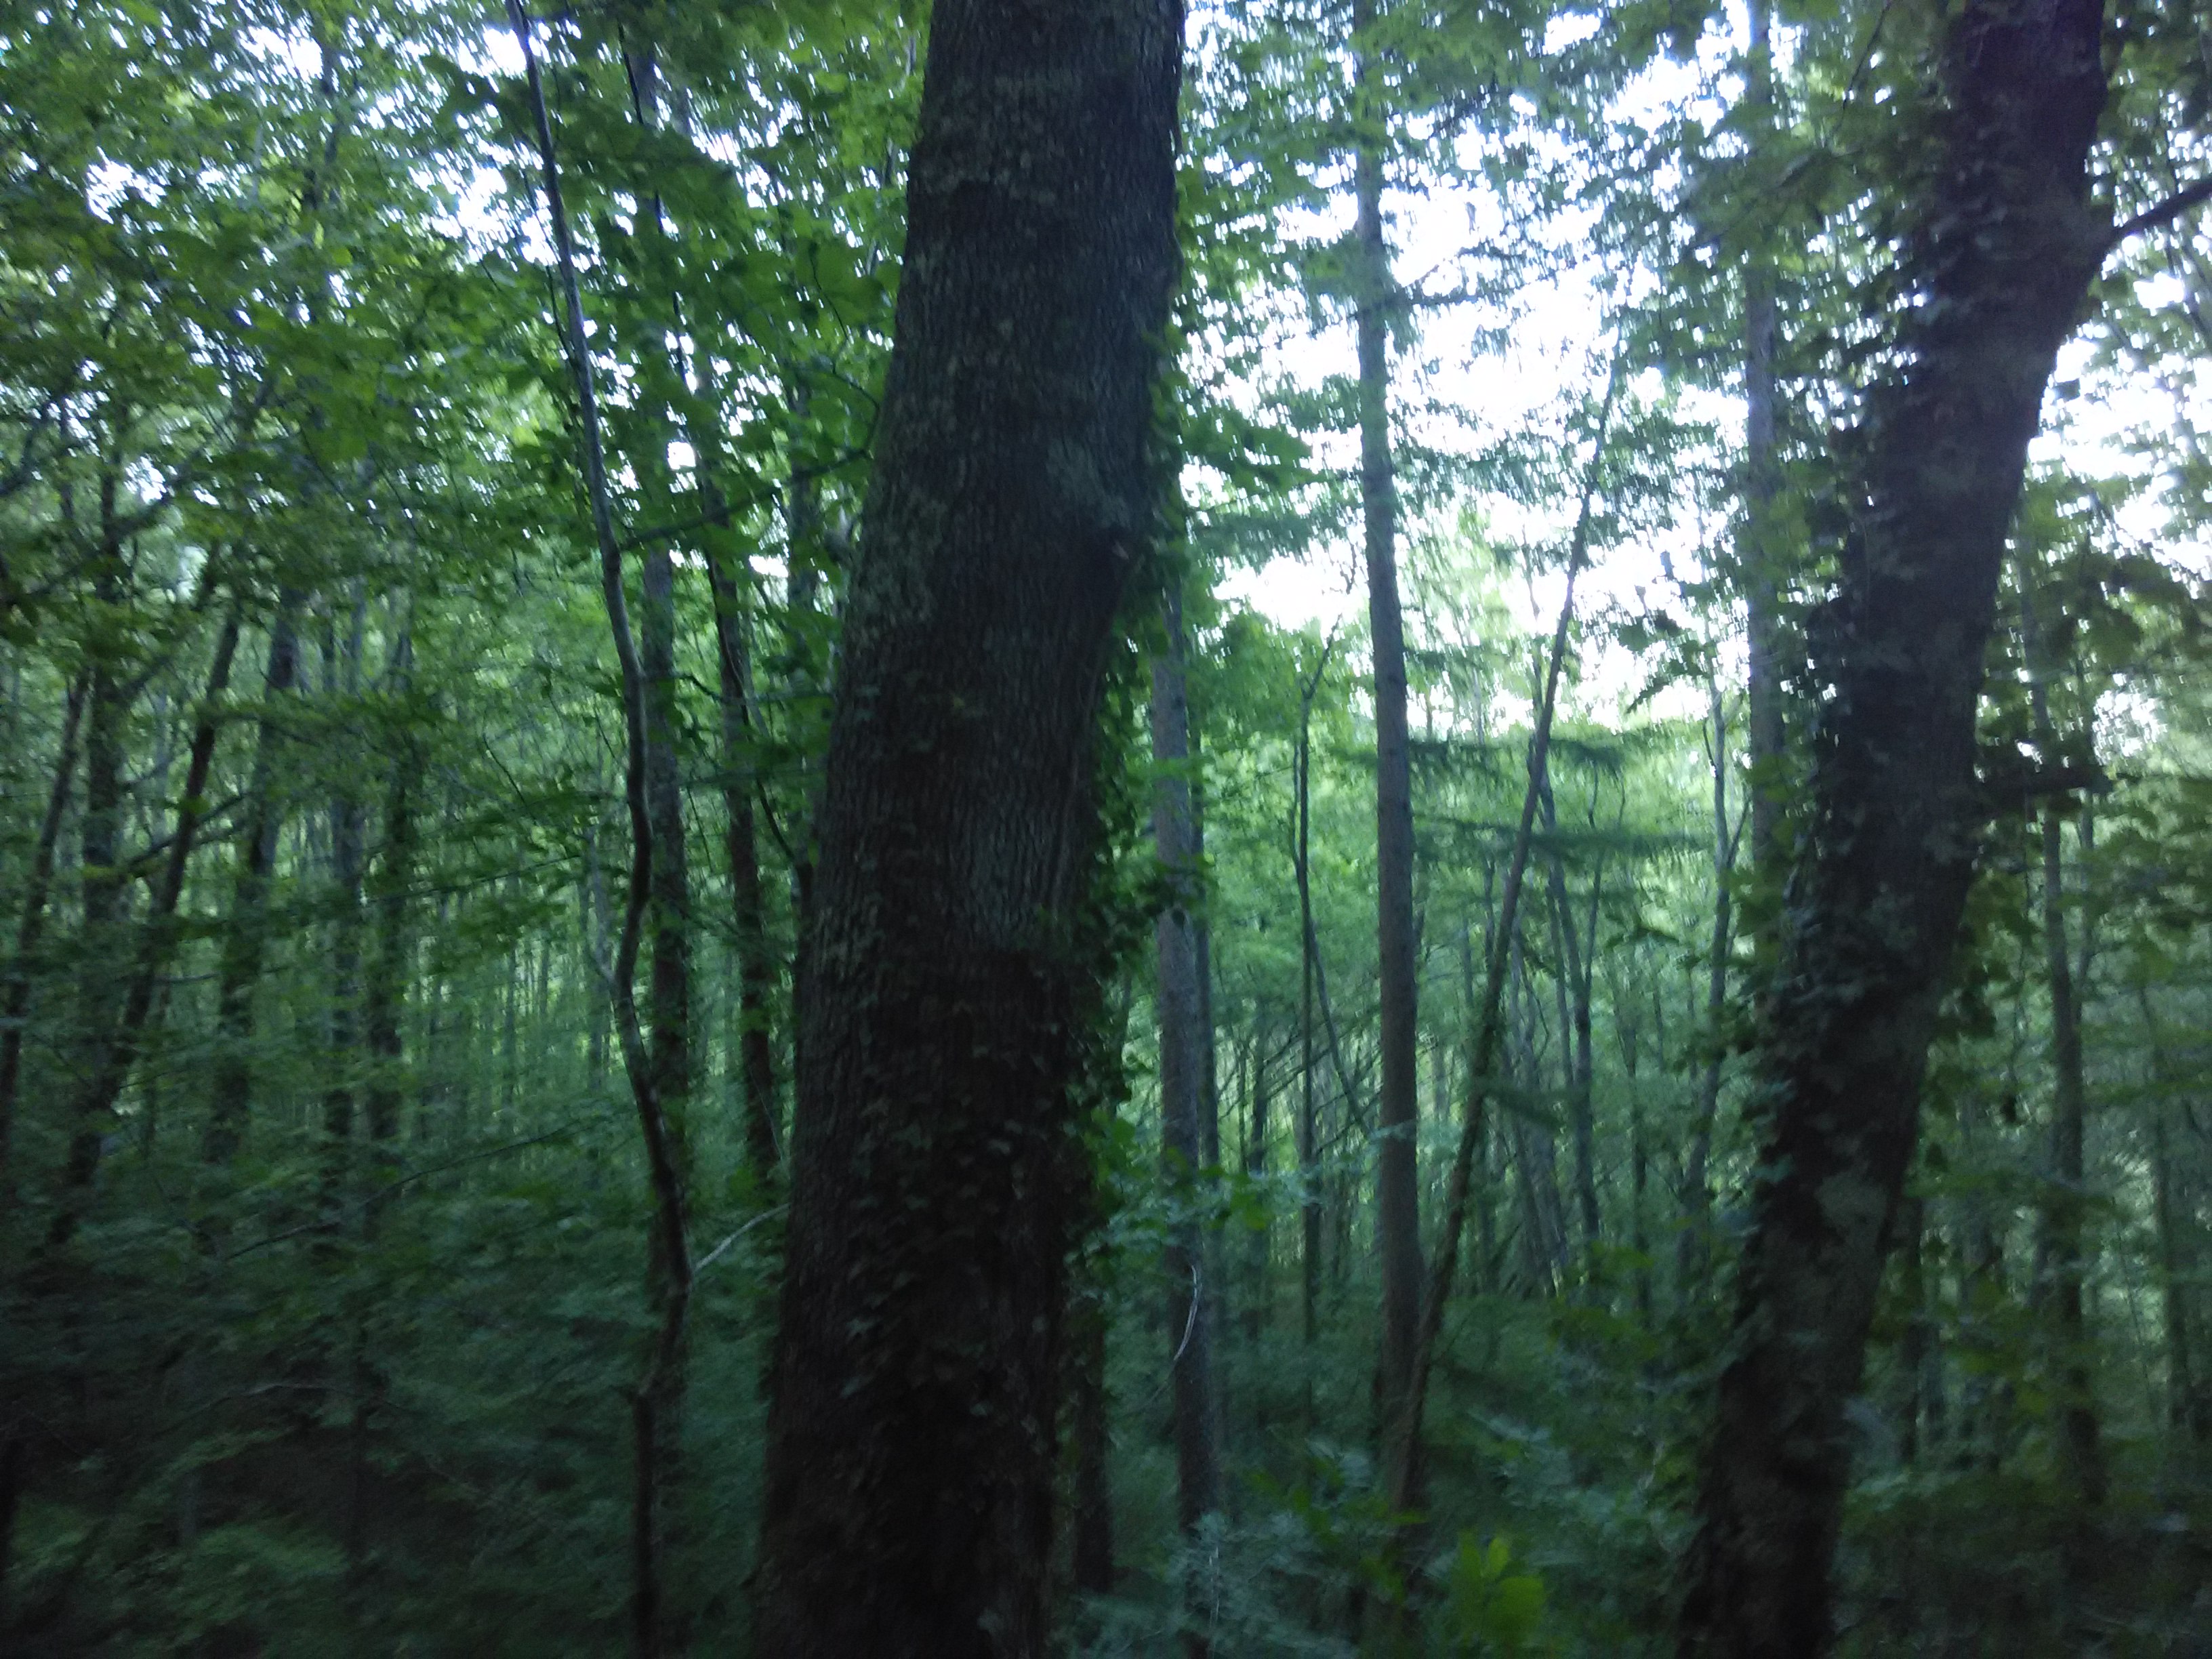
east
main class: Woodland
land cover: Broadleaved woodland
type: acidophilous oak and oak-birch forest
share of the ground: > 75 %
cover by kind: broadleaved forest trees 100 %
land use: Forestry
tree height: > 5 m
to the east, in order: Broadleaved woodland; Rivers and streams; Broadleaved woodland; Pine dominated coniferous woodland
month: June
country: ES
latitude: 43.0608
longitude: -2.3651
